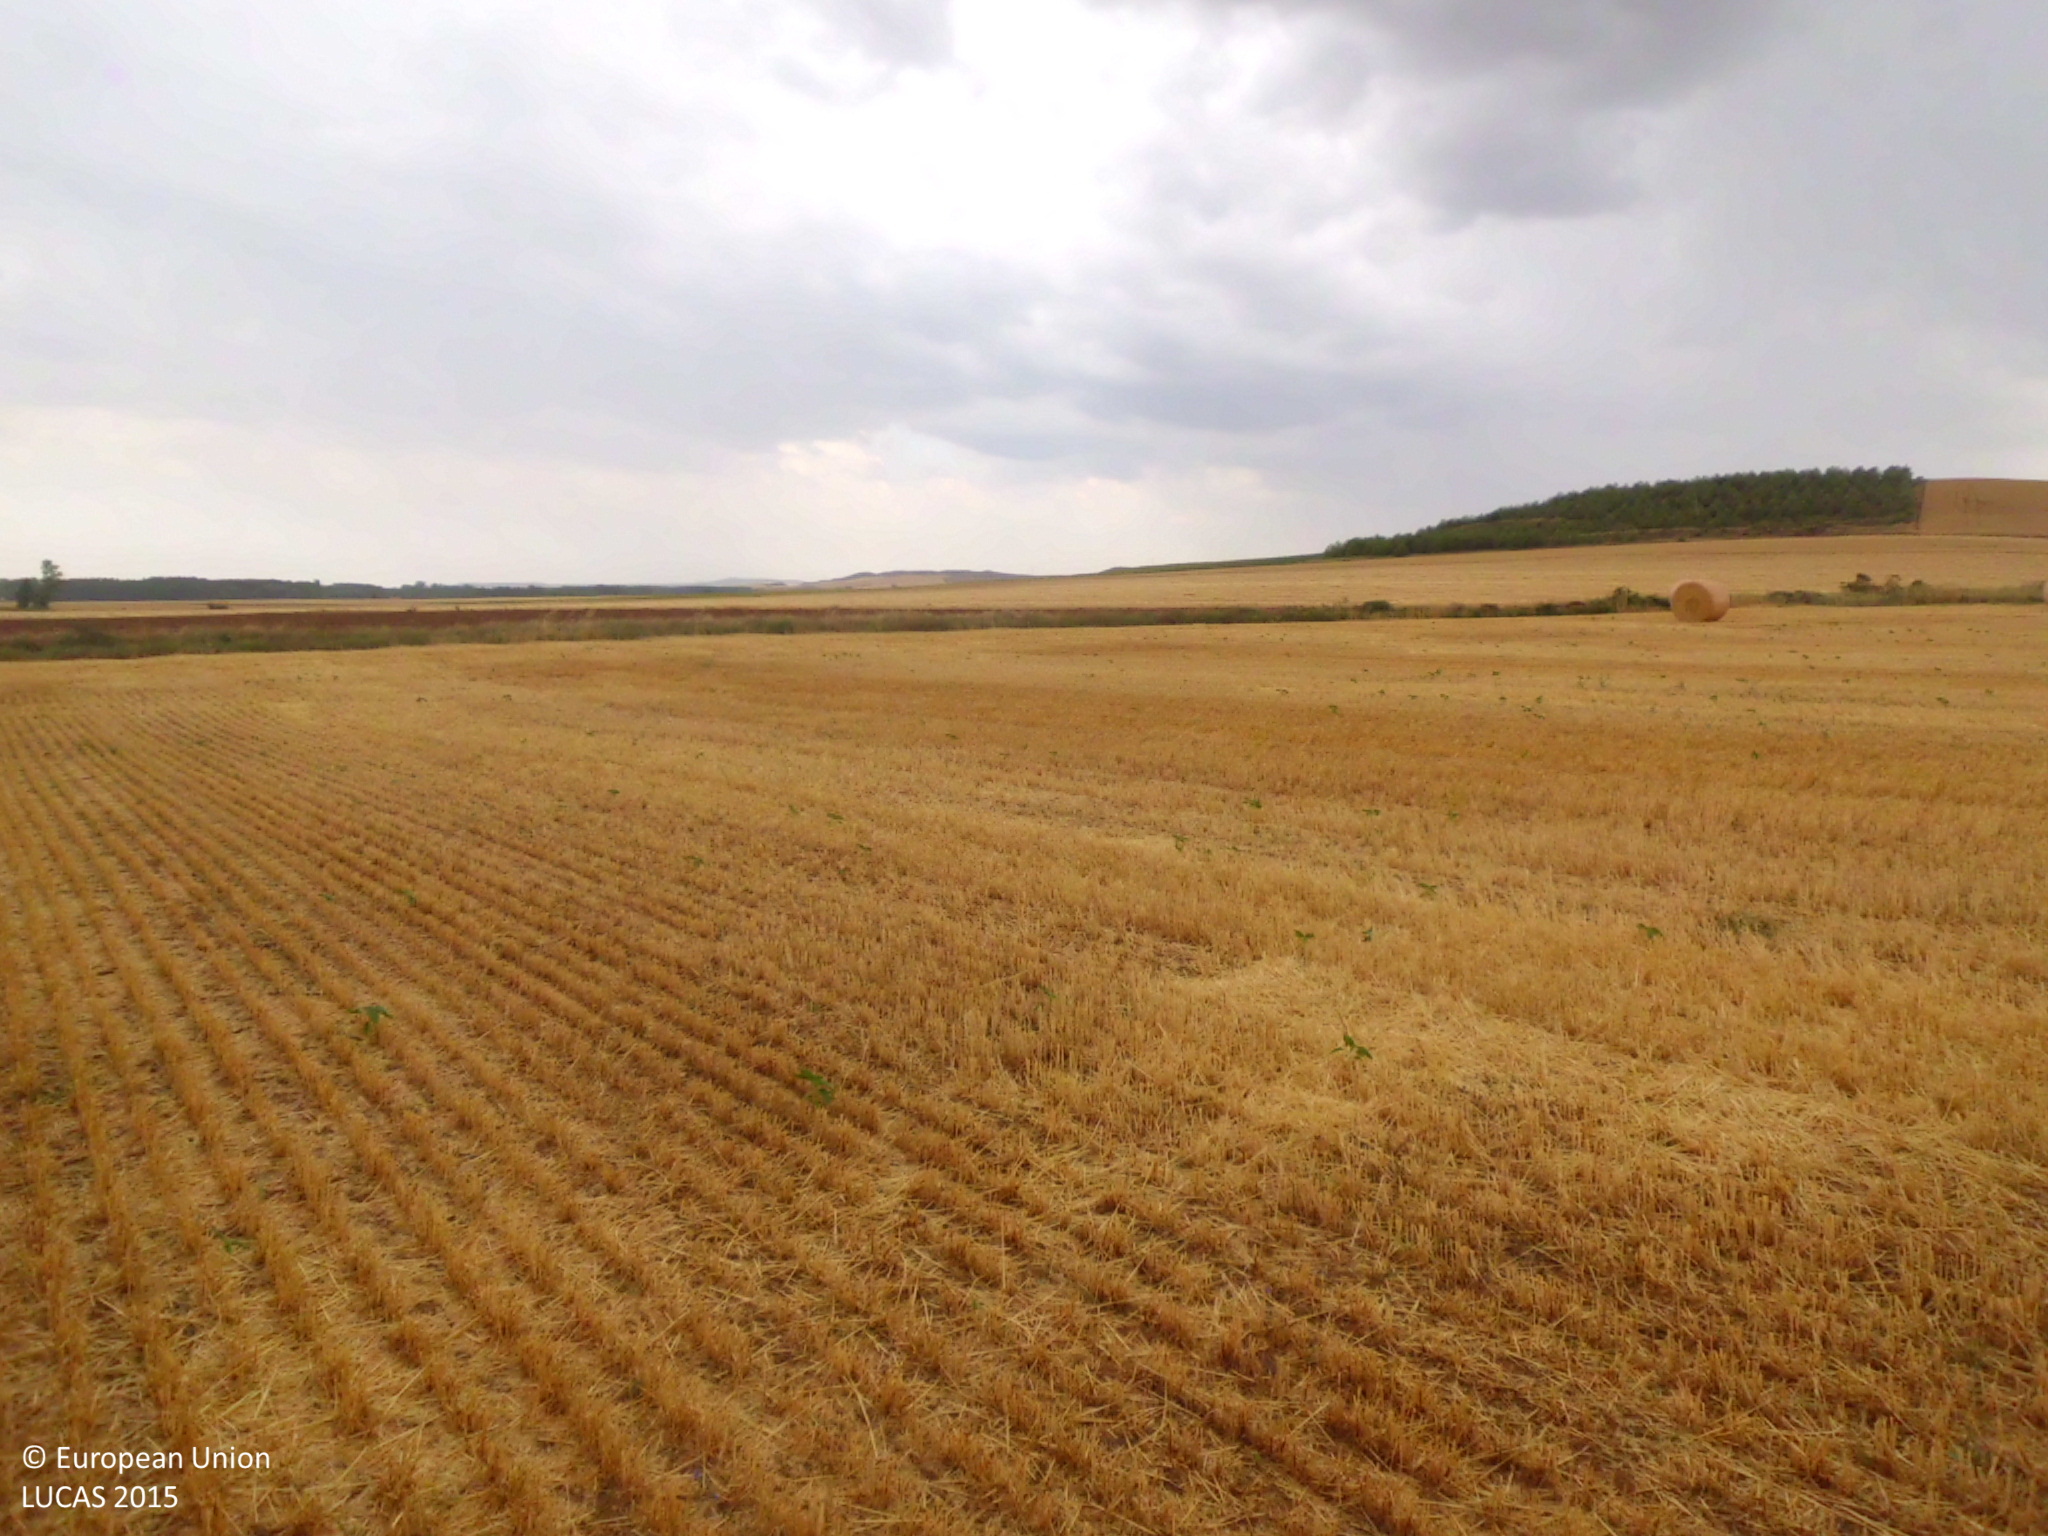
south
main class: Cropland
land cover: Common wheat
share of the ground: < 10 %
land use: Agriculture (excluding fallow land and kitchen gardens)
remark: Harvested field
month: July
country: ES
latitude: 42.6470
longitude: -4.3822
